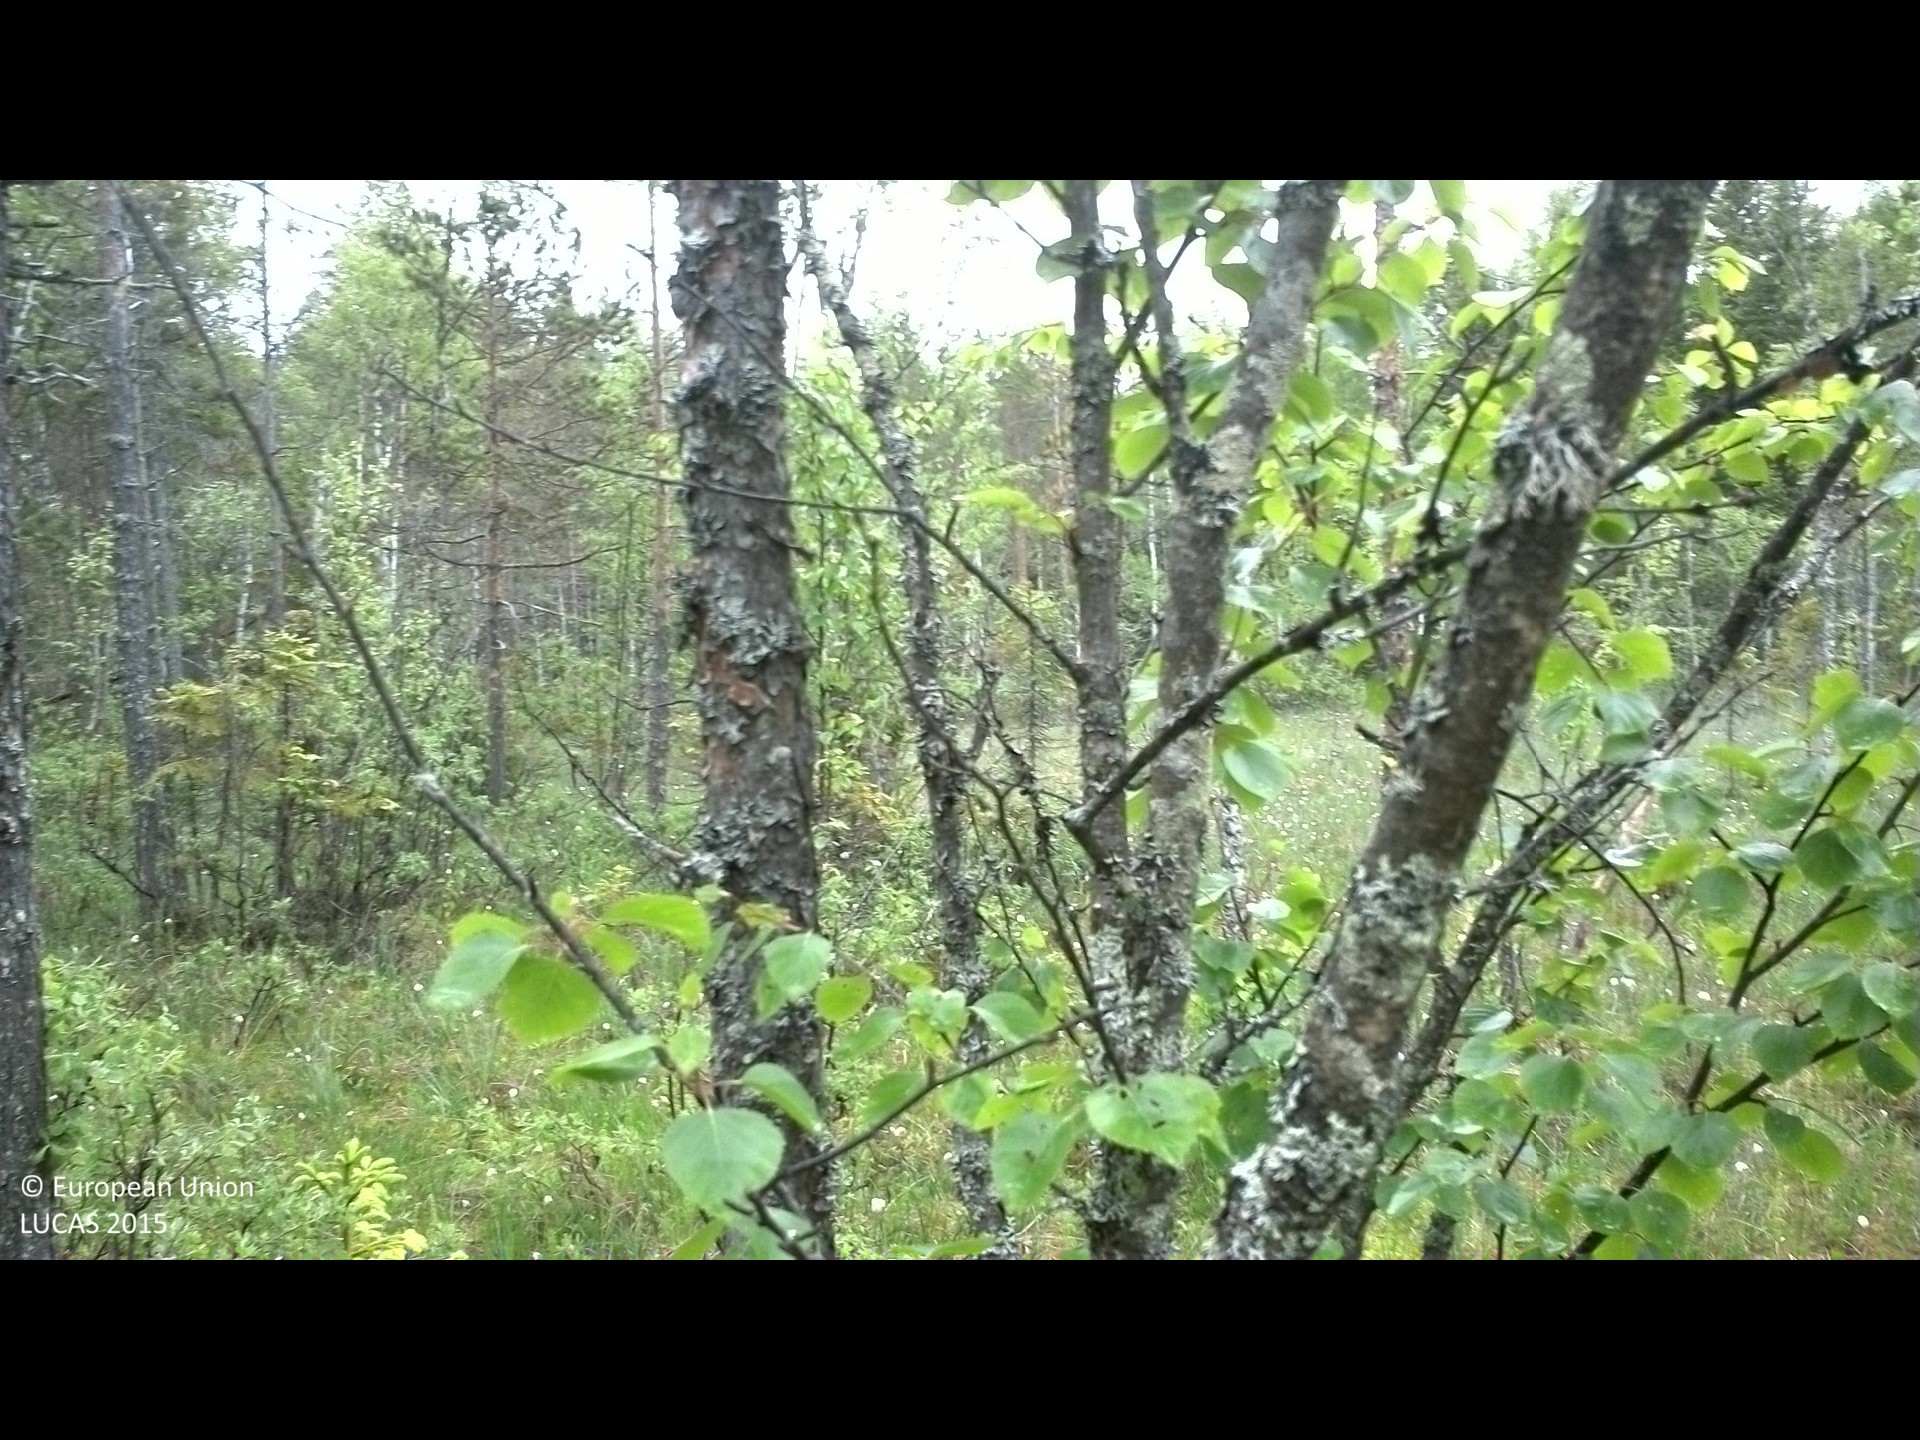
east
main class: Woodland
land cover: Pine dominated mixed woodland
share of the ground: 10 - 25 %
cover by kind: lichens and mosses 50 %, shrubs 25 %, coniferous forest trees 10 %, herbaceous plants 10 %, broadleaved forest trees 5 %
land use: Forestry
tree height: > 5 m
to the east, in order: Pine dominated mixed woodland; Spruce dominated mixed woodland; Spruce dominated coniferous woodland; Pine dominated mixed woodland
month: June
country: SE
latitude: 61.9186
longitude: 17.1239
